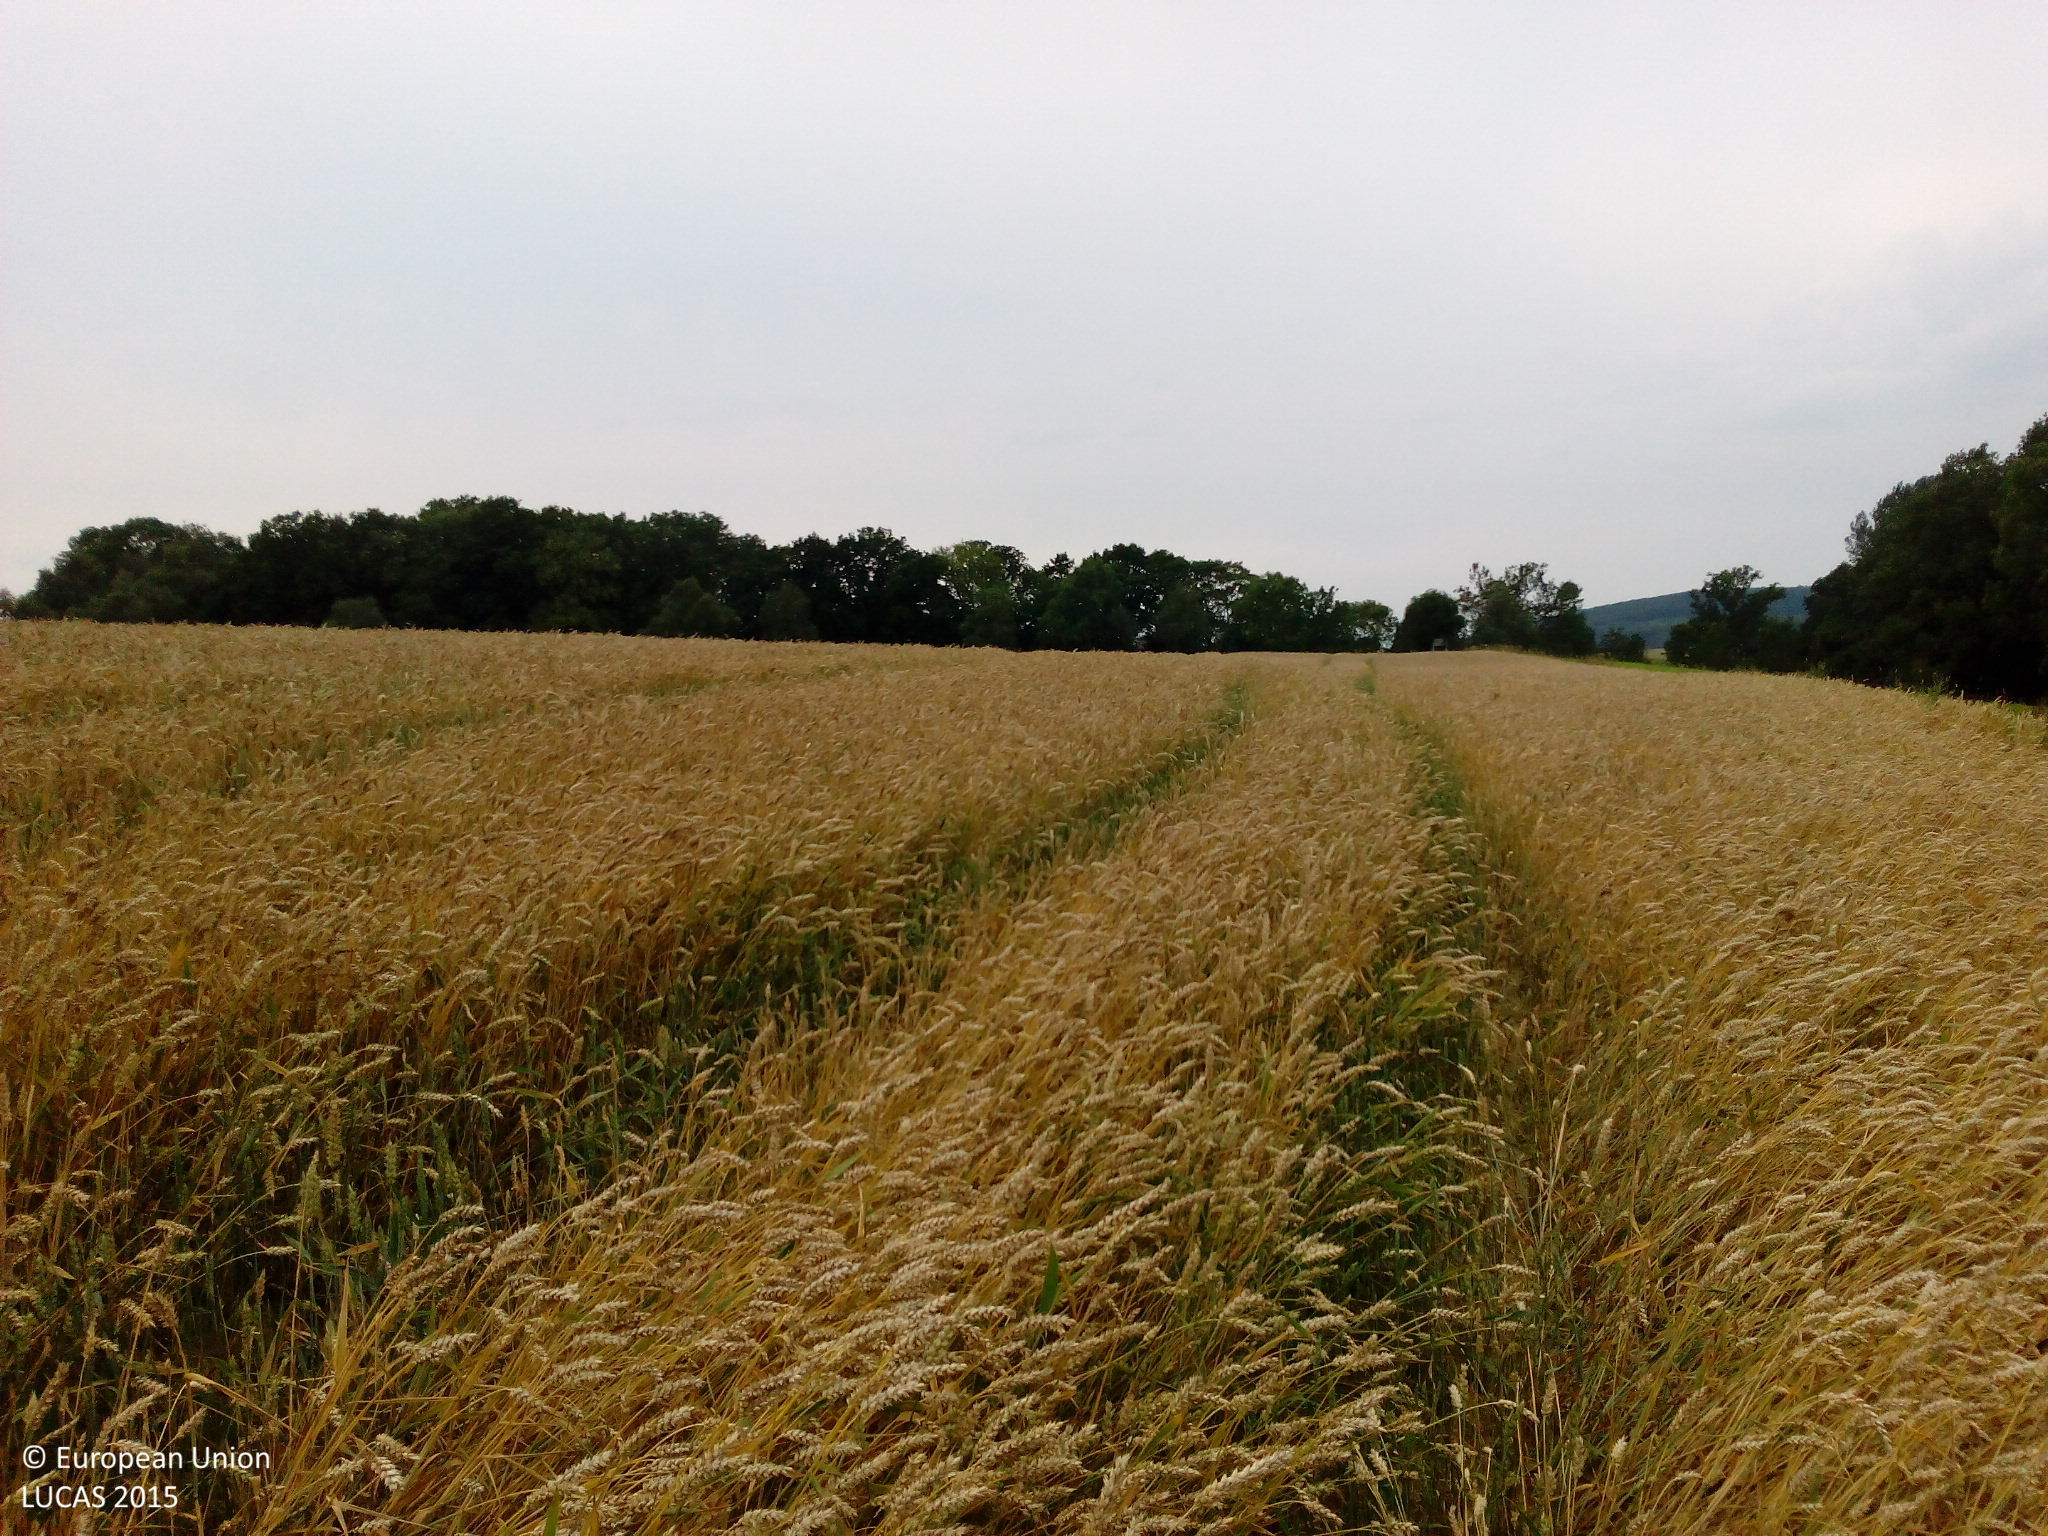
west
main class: Cropland
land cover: Triticale
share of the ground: > 75 %
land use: Agriculture (excluding fallow land and kitchen gardens)
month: August
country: DE
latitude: 51.8541
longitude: 9.2888
